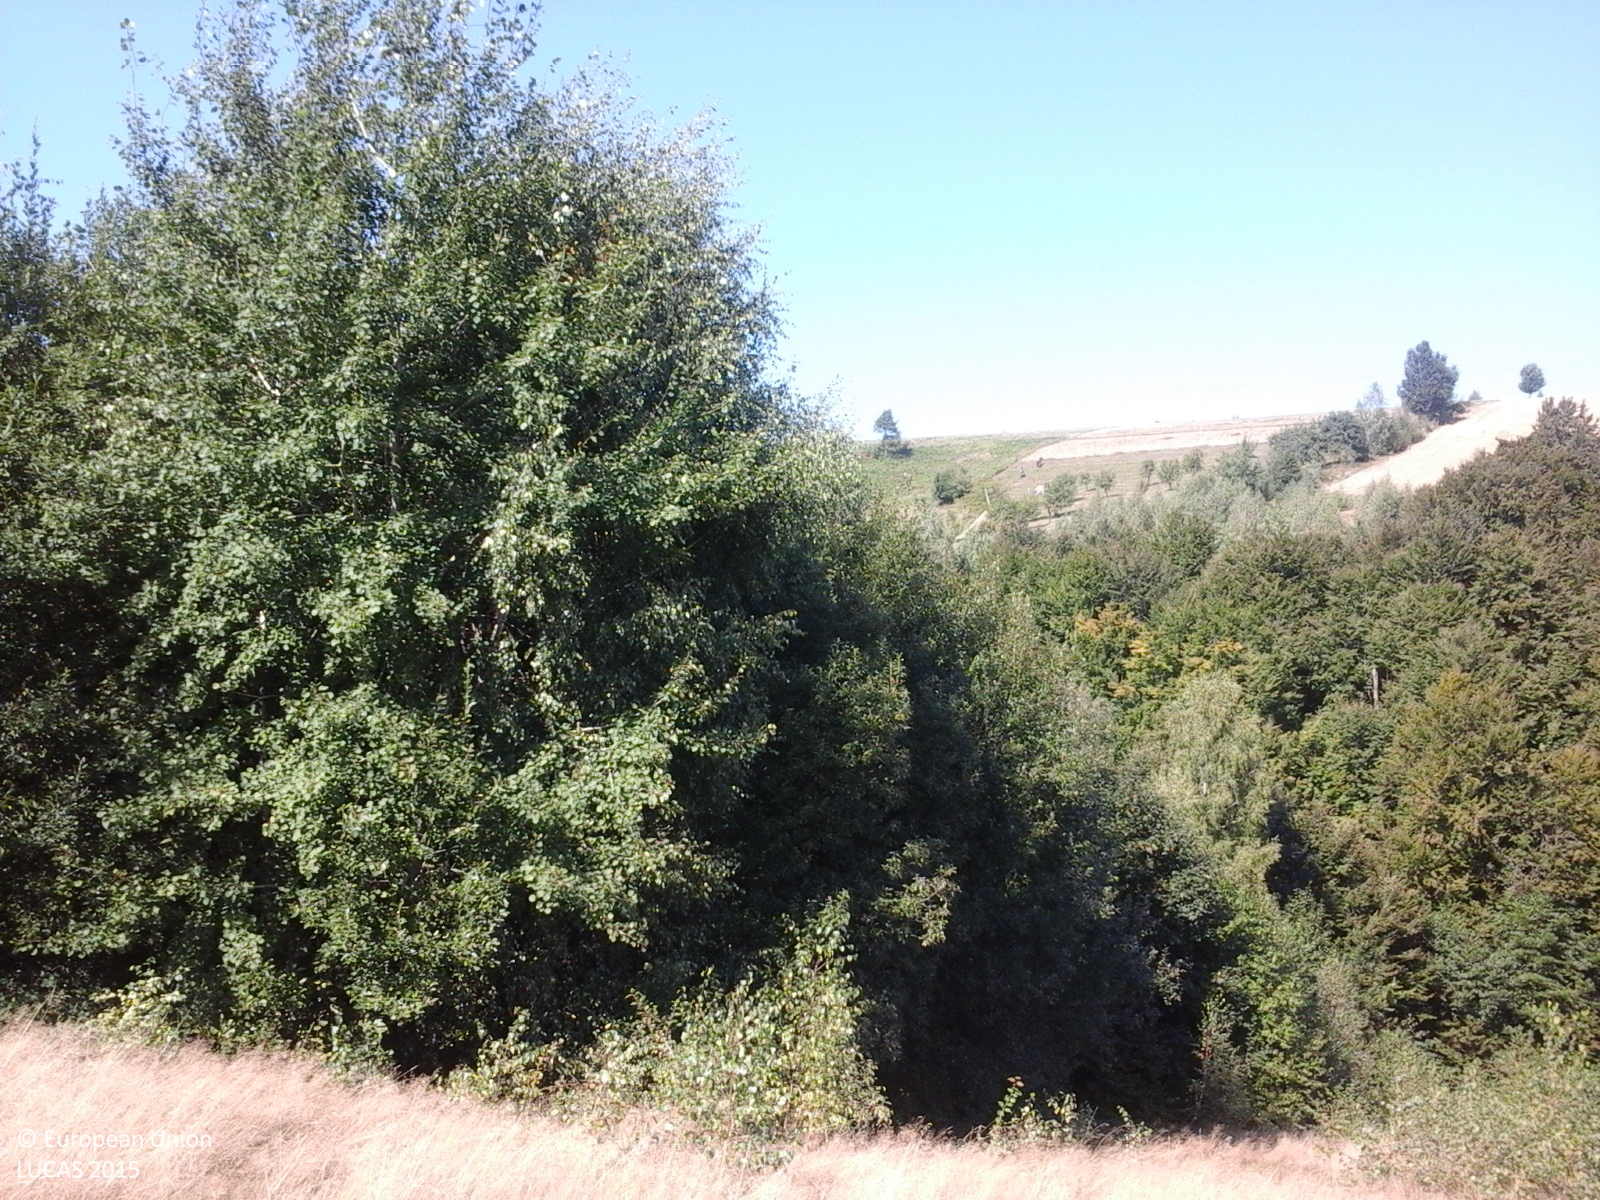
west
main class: Grassland
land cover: Grassland with sparse tree/shrub cover
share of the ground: > 75 %
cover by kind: herbaceous plants 85 %, shrubs 10 %, broadleaved forest trees 5 %
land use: Agriculture (excluding fallow land and kitchen gardens)
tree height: < 5 m
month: September
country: RO
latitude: 47.1043
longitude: 22.5338
